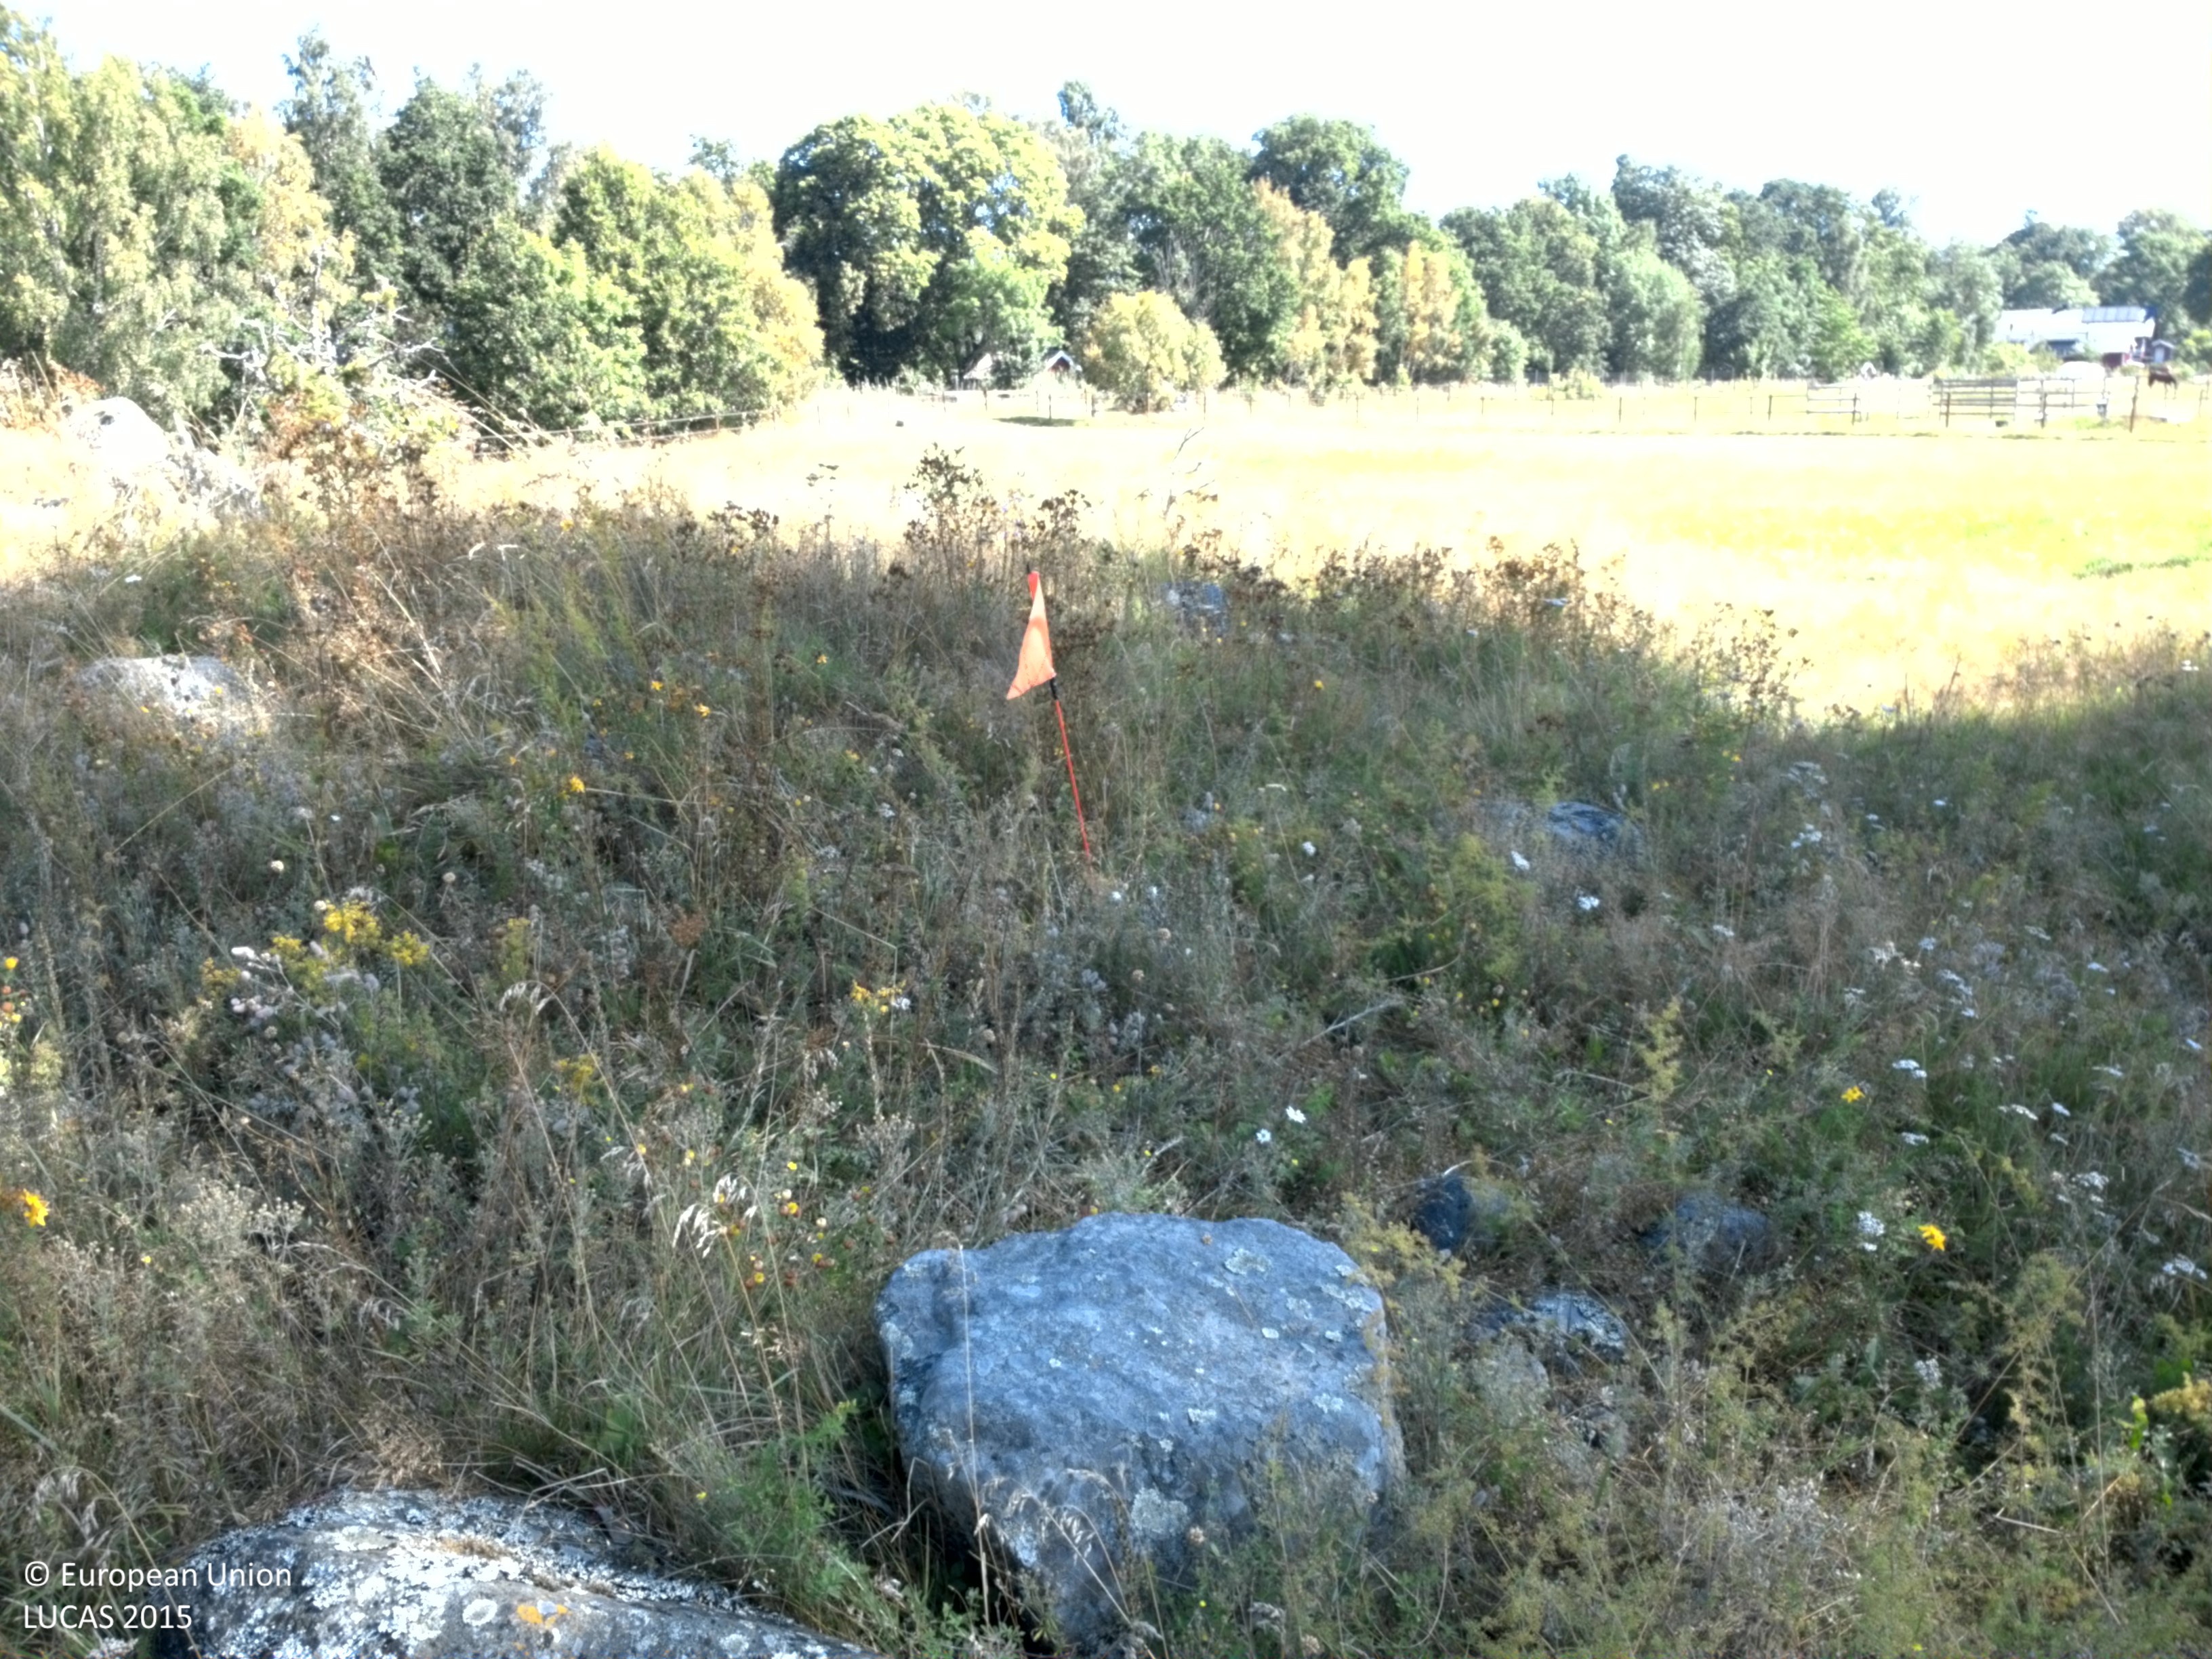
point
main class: Grassland
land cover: Grassland without tree/shrub cover
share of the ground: > 75 %
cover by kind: herbaceous plants 100 %
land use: Agriculture (excluding fallow land and kitchen gardens)
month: August
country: SE
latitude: 59.6138
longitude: 17.5989
